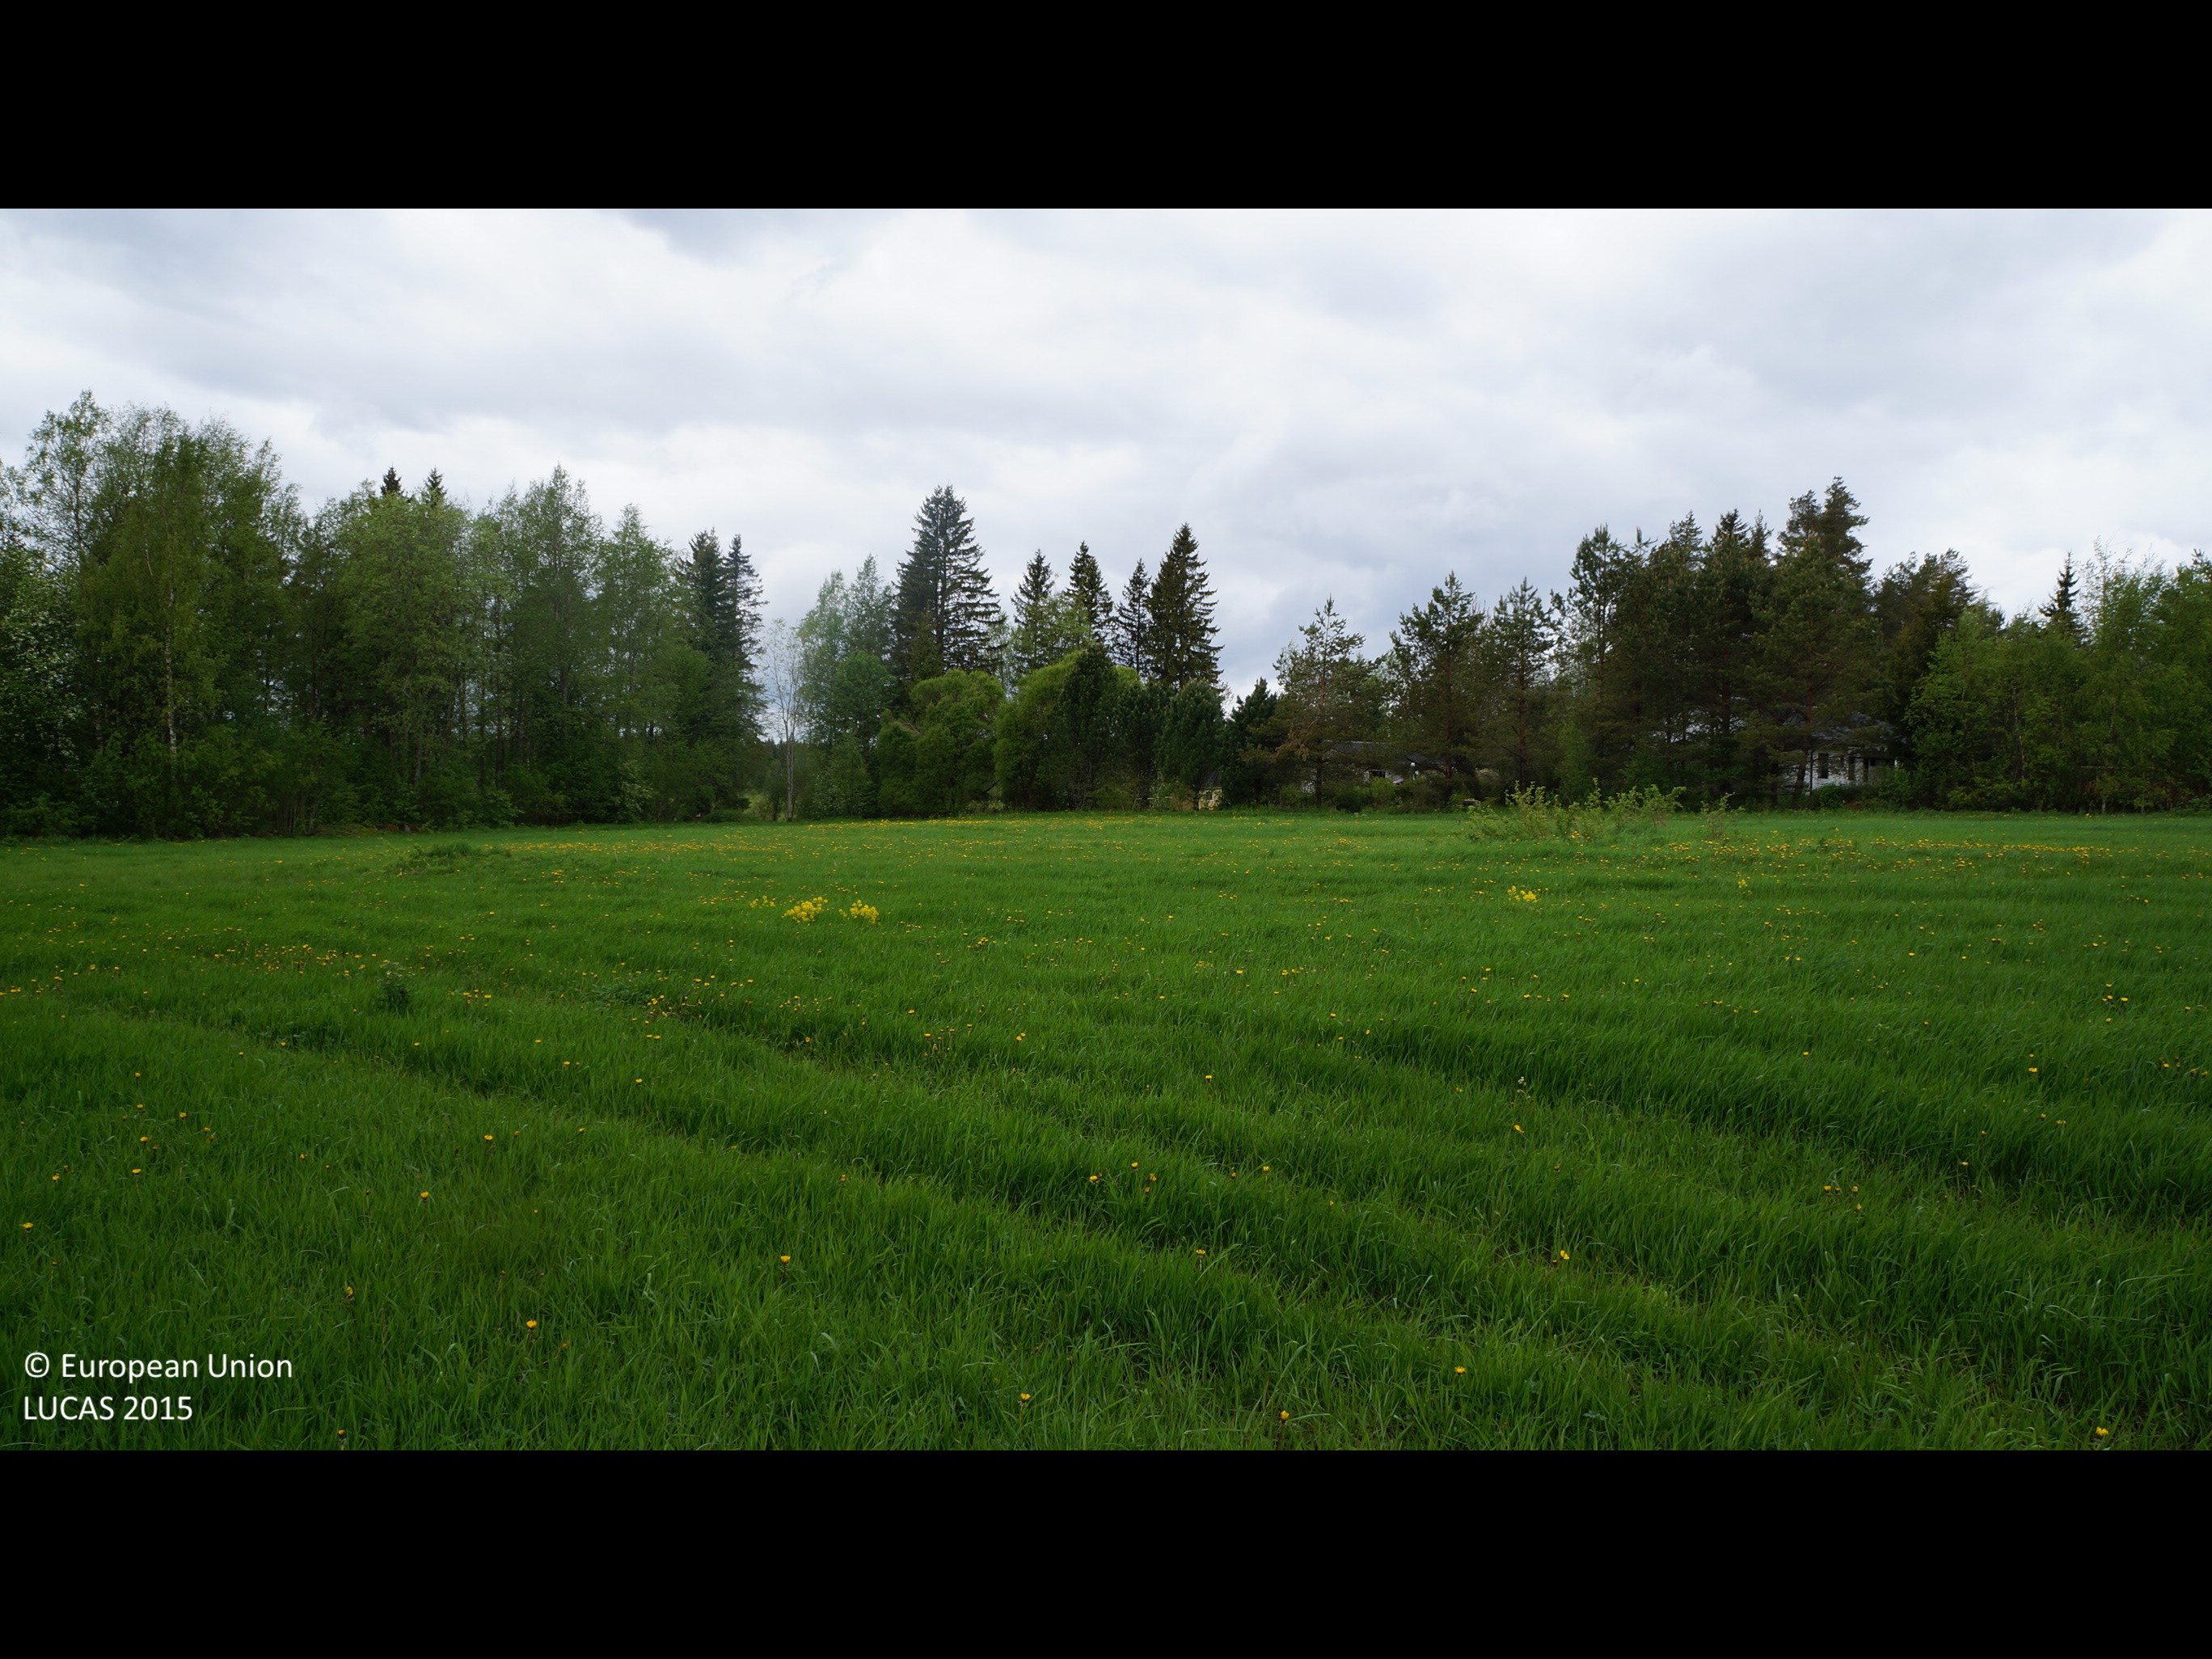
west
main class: Cropland
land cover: Temporary grasslands
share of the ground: > 75 %
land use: Agriculture (excluding fallow land and kitchen gardens)
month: June
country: FI
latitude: 63.8119
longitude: 23.3594
